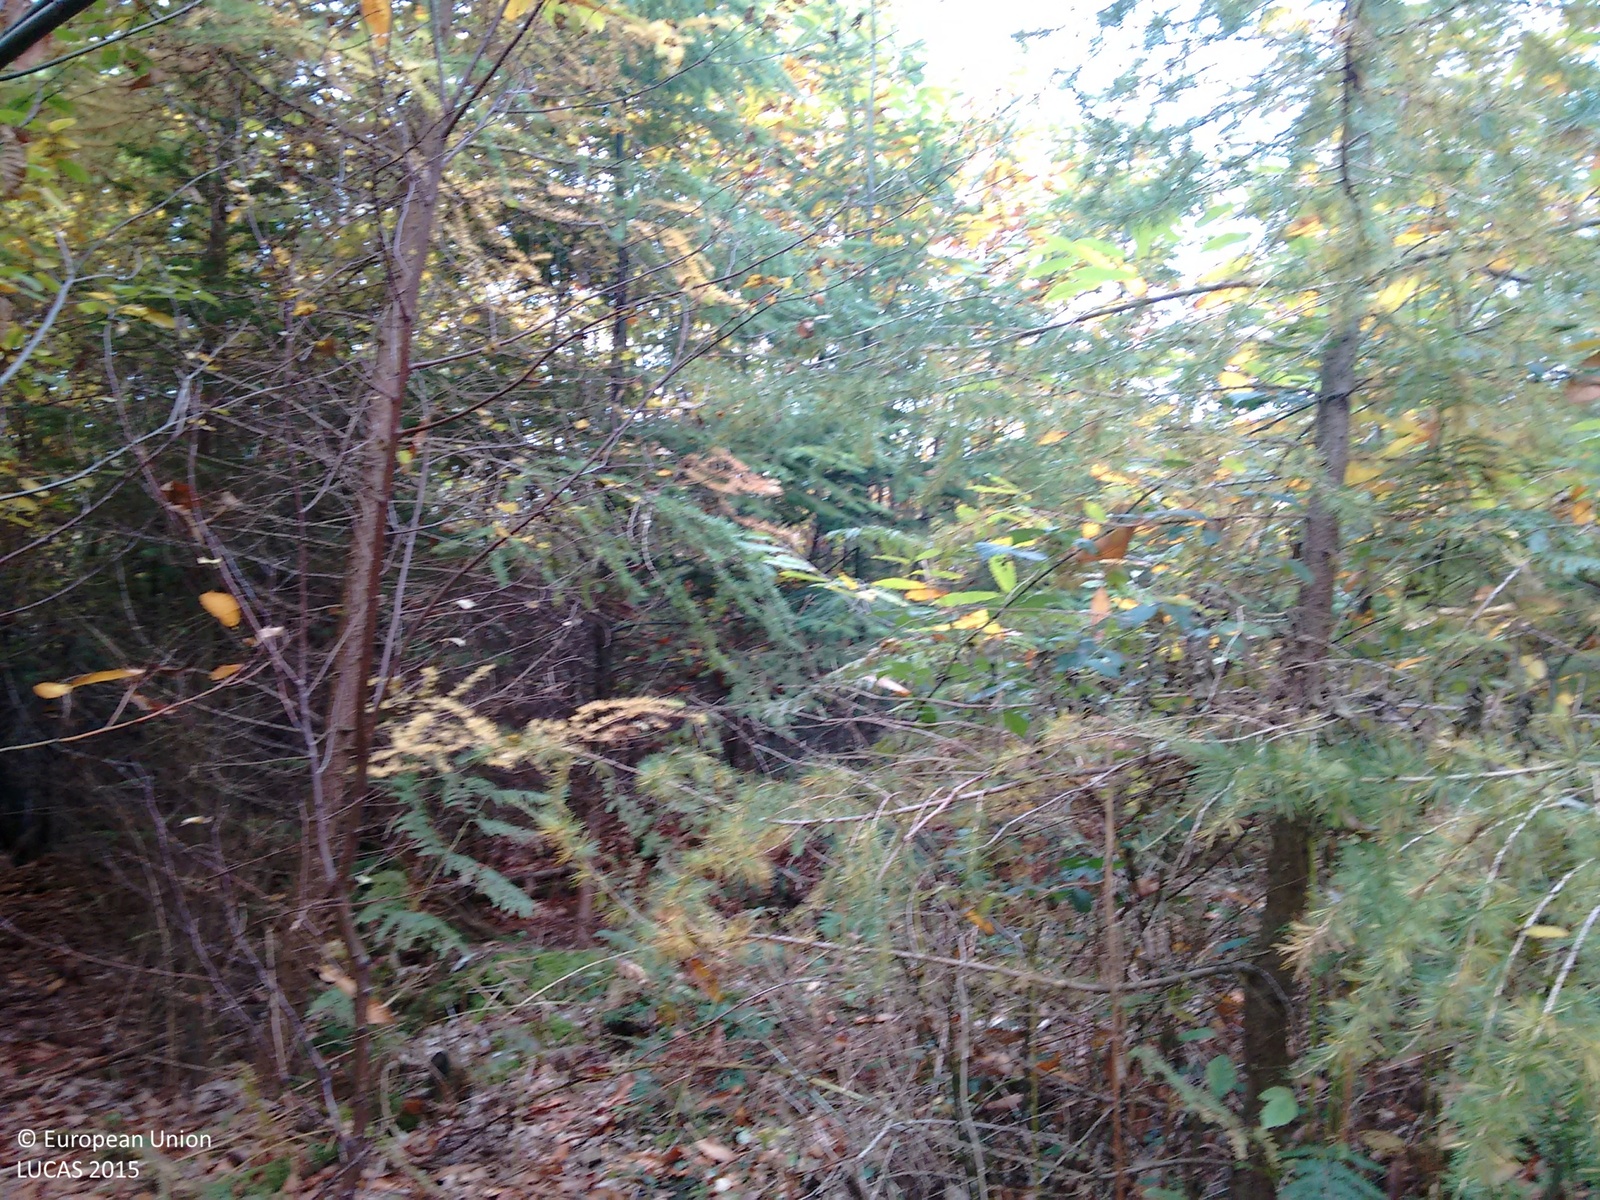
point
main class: Woodland
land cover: Other coniferous woodland
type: exotic forest
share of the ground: > 75 %
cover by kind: coniferous forest trees 60 %, broadleaved forest trees 20 %, shrubs 20 %
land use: Forestry
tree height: > 5 m
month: October
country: GB
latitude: 51.7989
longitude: -2.5525
